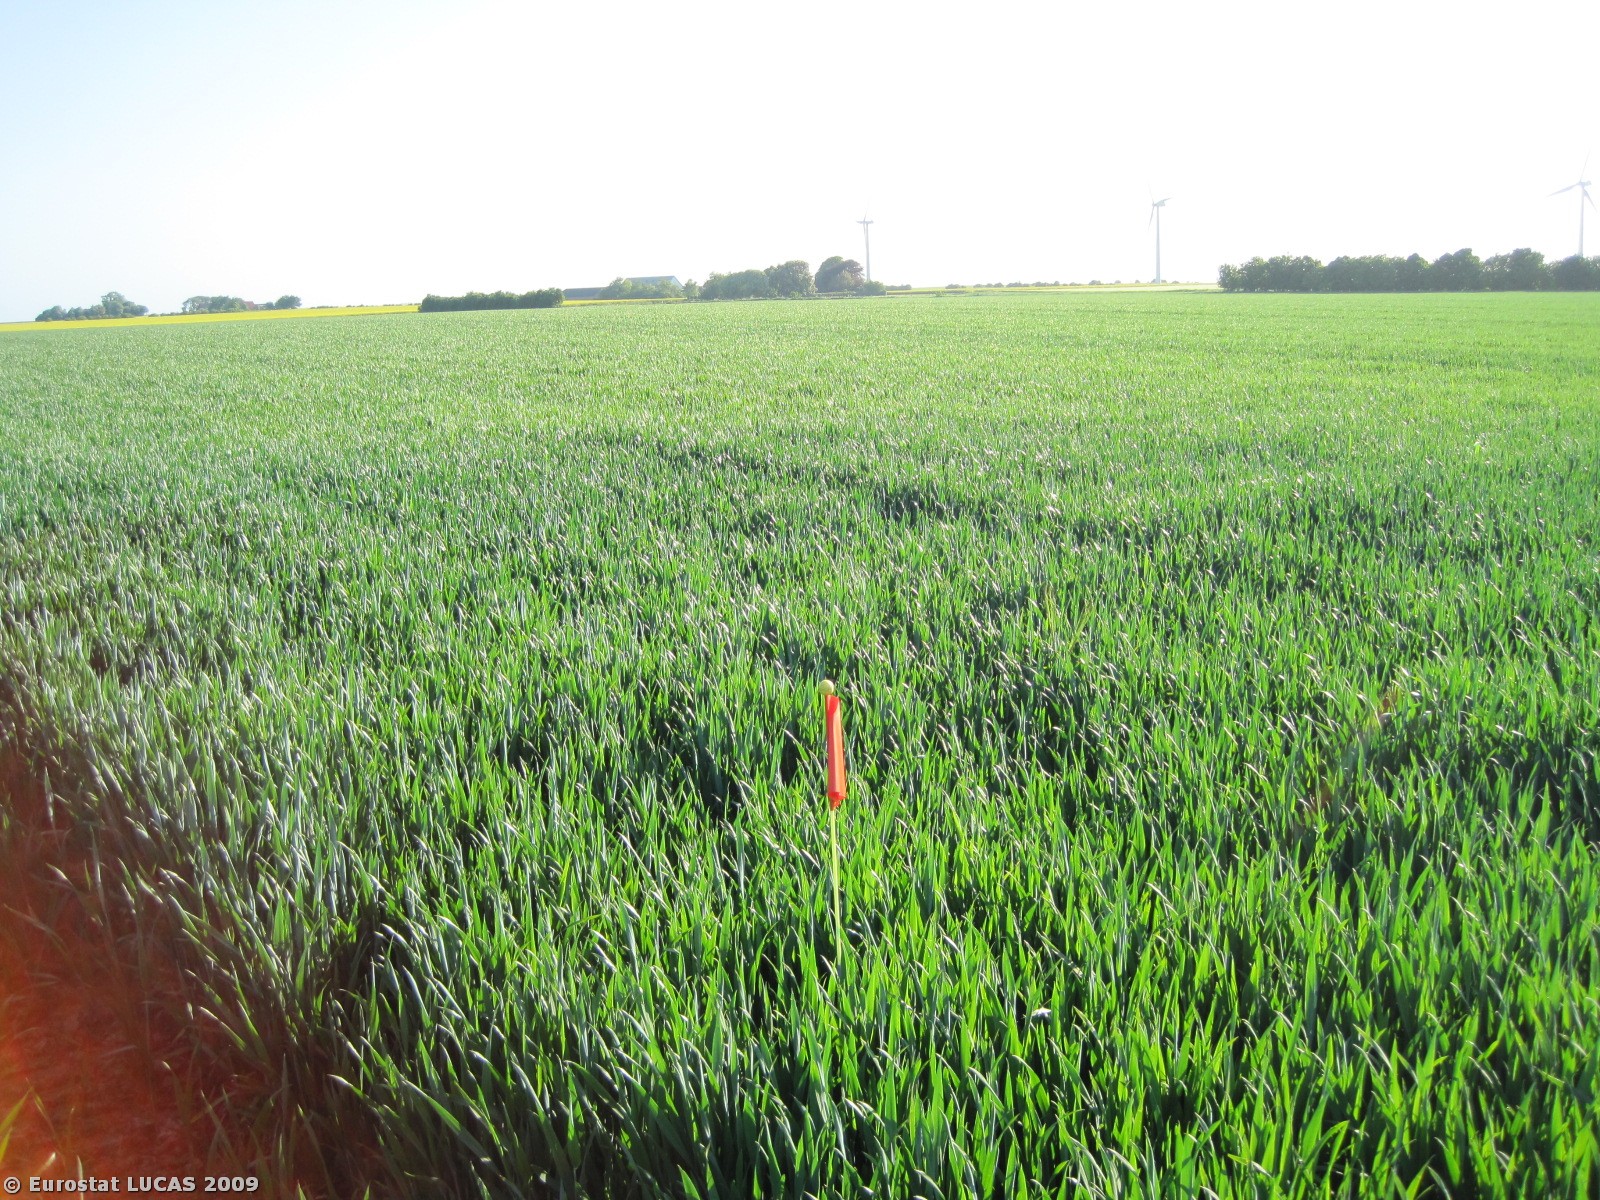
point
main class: Cropland
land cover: Common wheat
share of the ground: > 75 %
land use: Agriculture (excluding fallow land and kitchen gardens)
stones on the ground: < 10 %
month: May
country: DK
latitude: 56.6190
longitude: 10.2116
